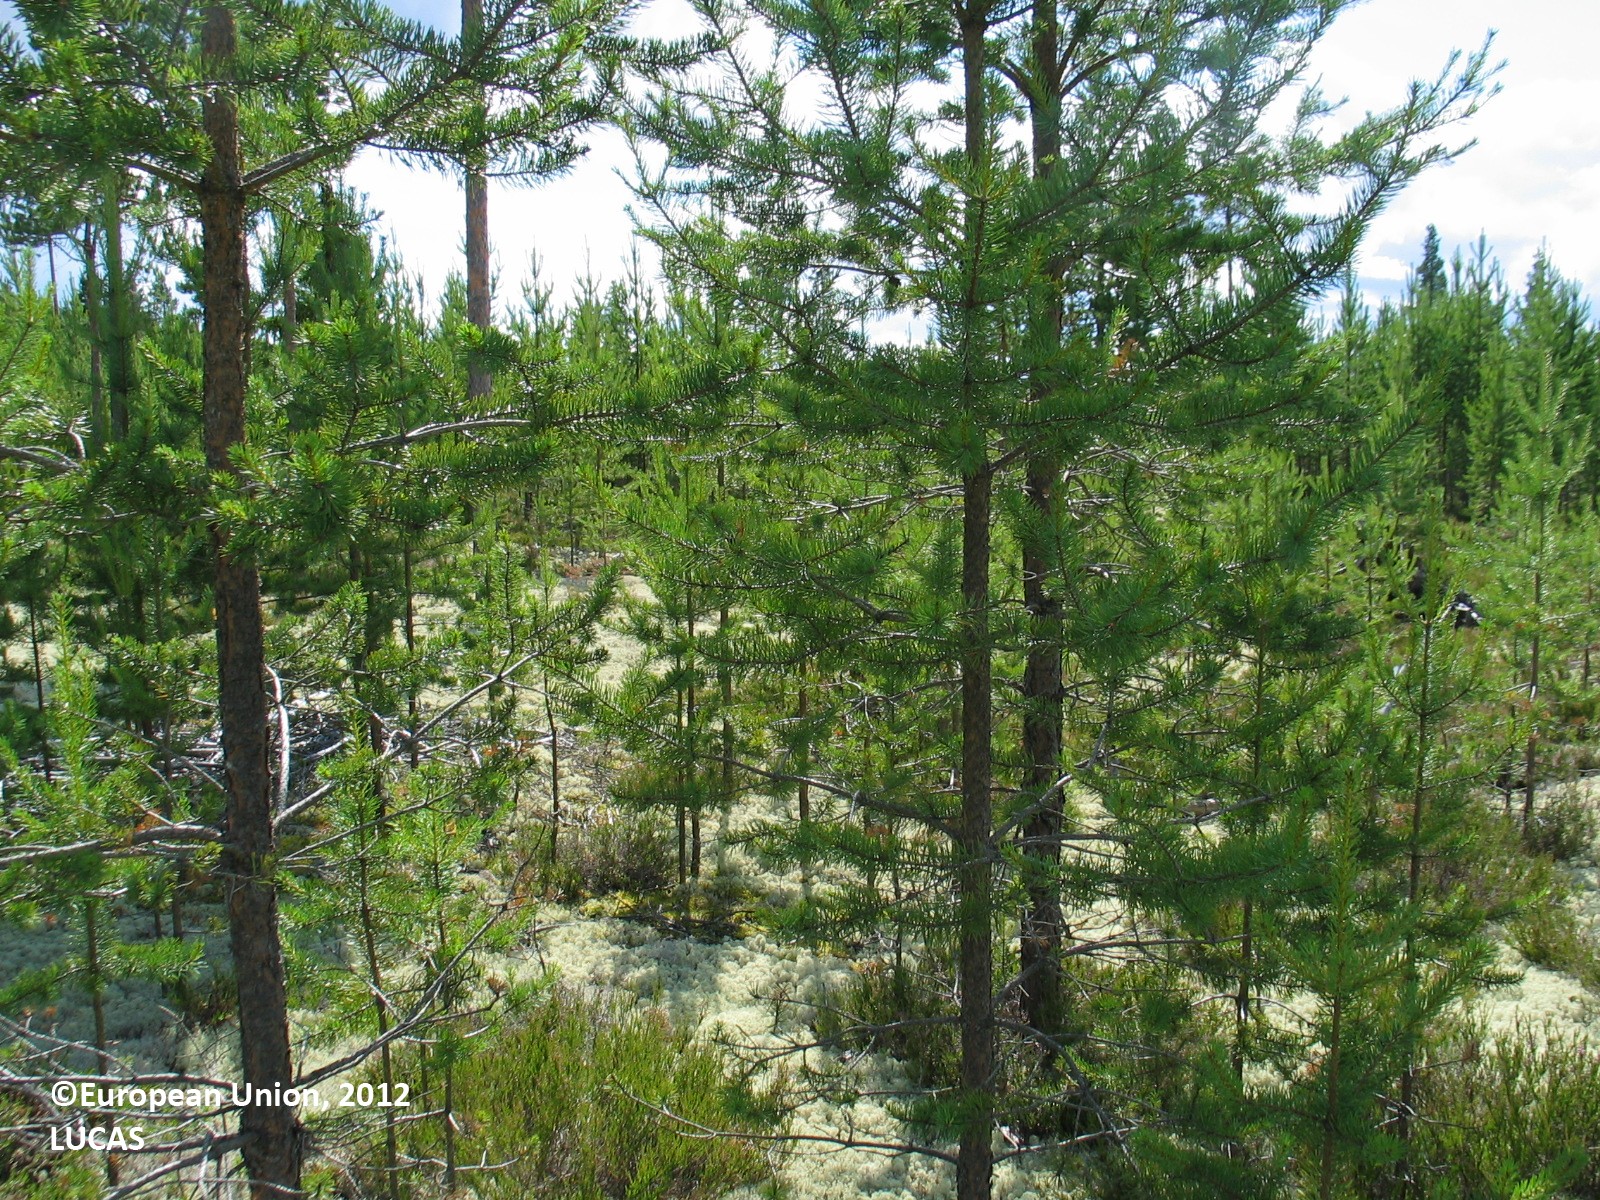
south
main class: Woodland
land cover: Pine dominated coniferous woodland
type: boreal forest
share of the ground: 25 - 50 %
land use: Forestry
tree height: > 5 m
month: July
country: FI
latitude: 64.6077
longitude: 26.4350
